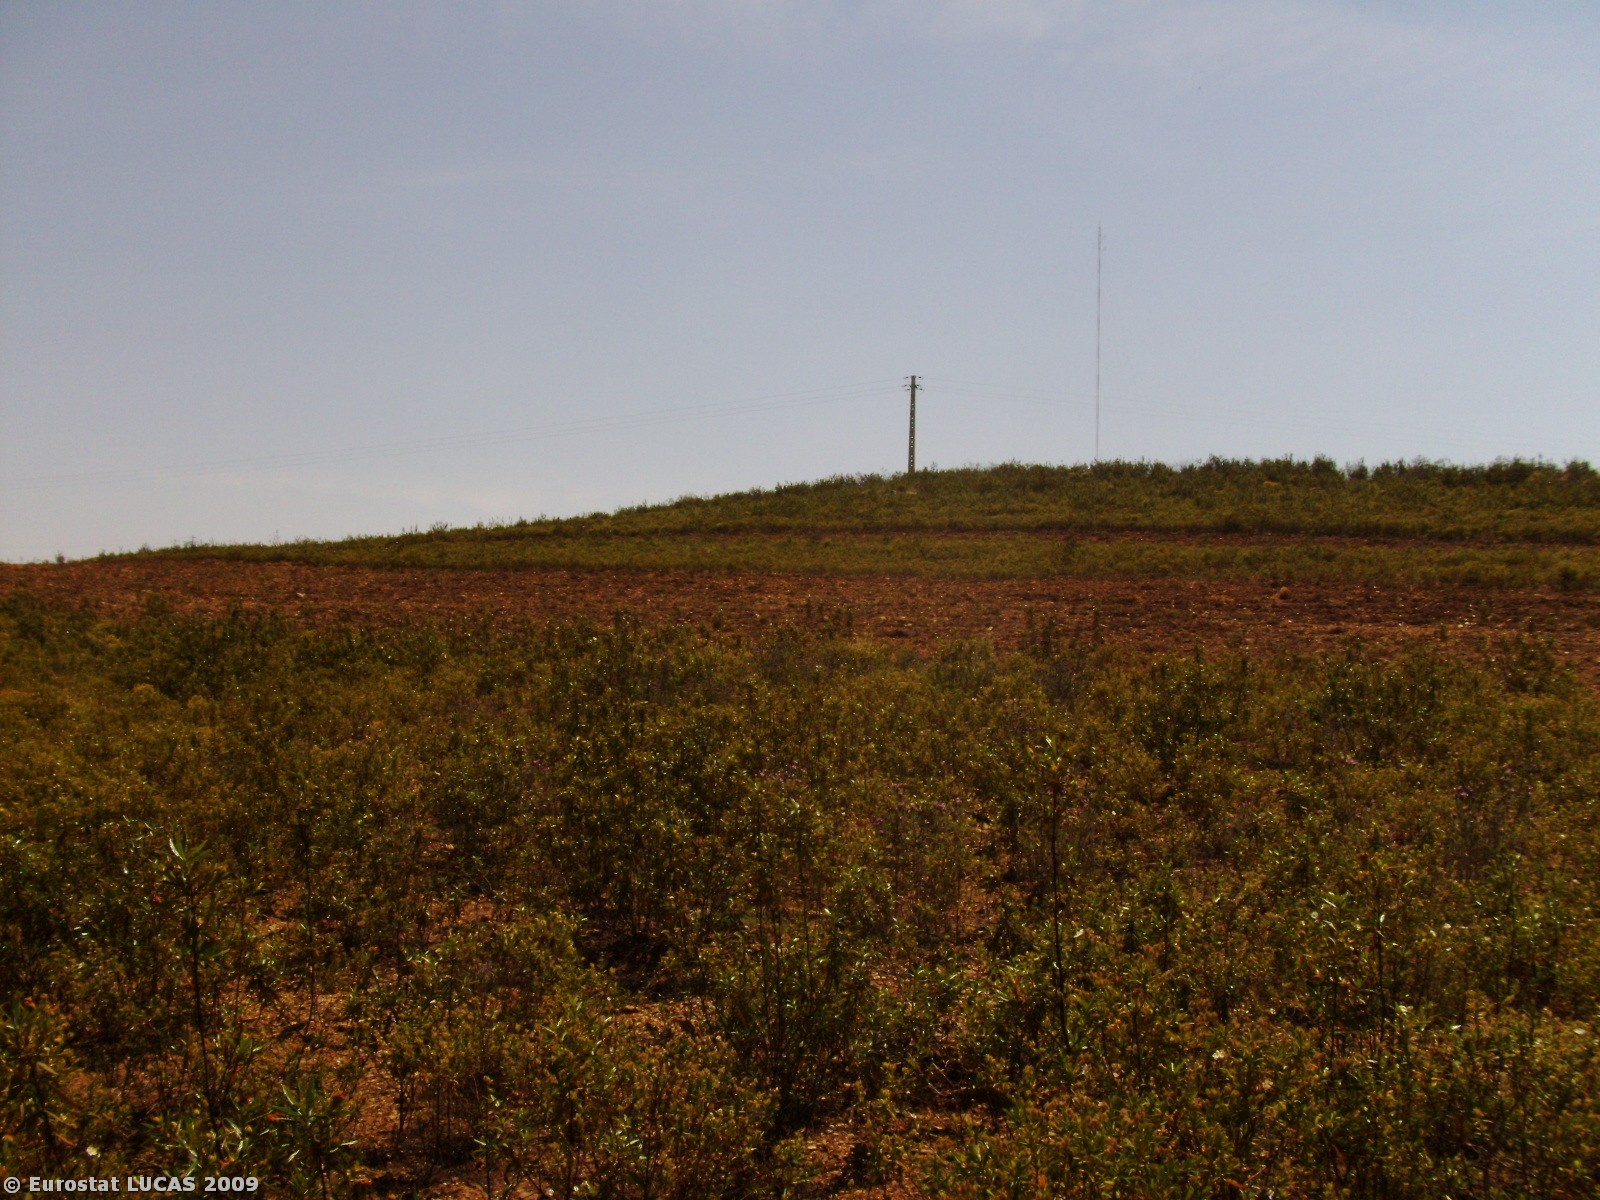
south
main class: Shrubland
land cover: Shrubland without tree cover
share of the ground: 50 - 75 %
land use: Unused
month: May
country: PT
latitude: 37.4356
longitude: -7.5379
